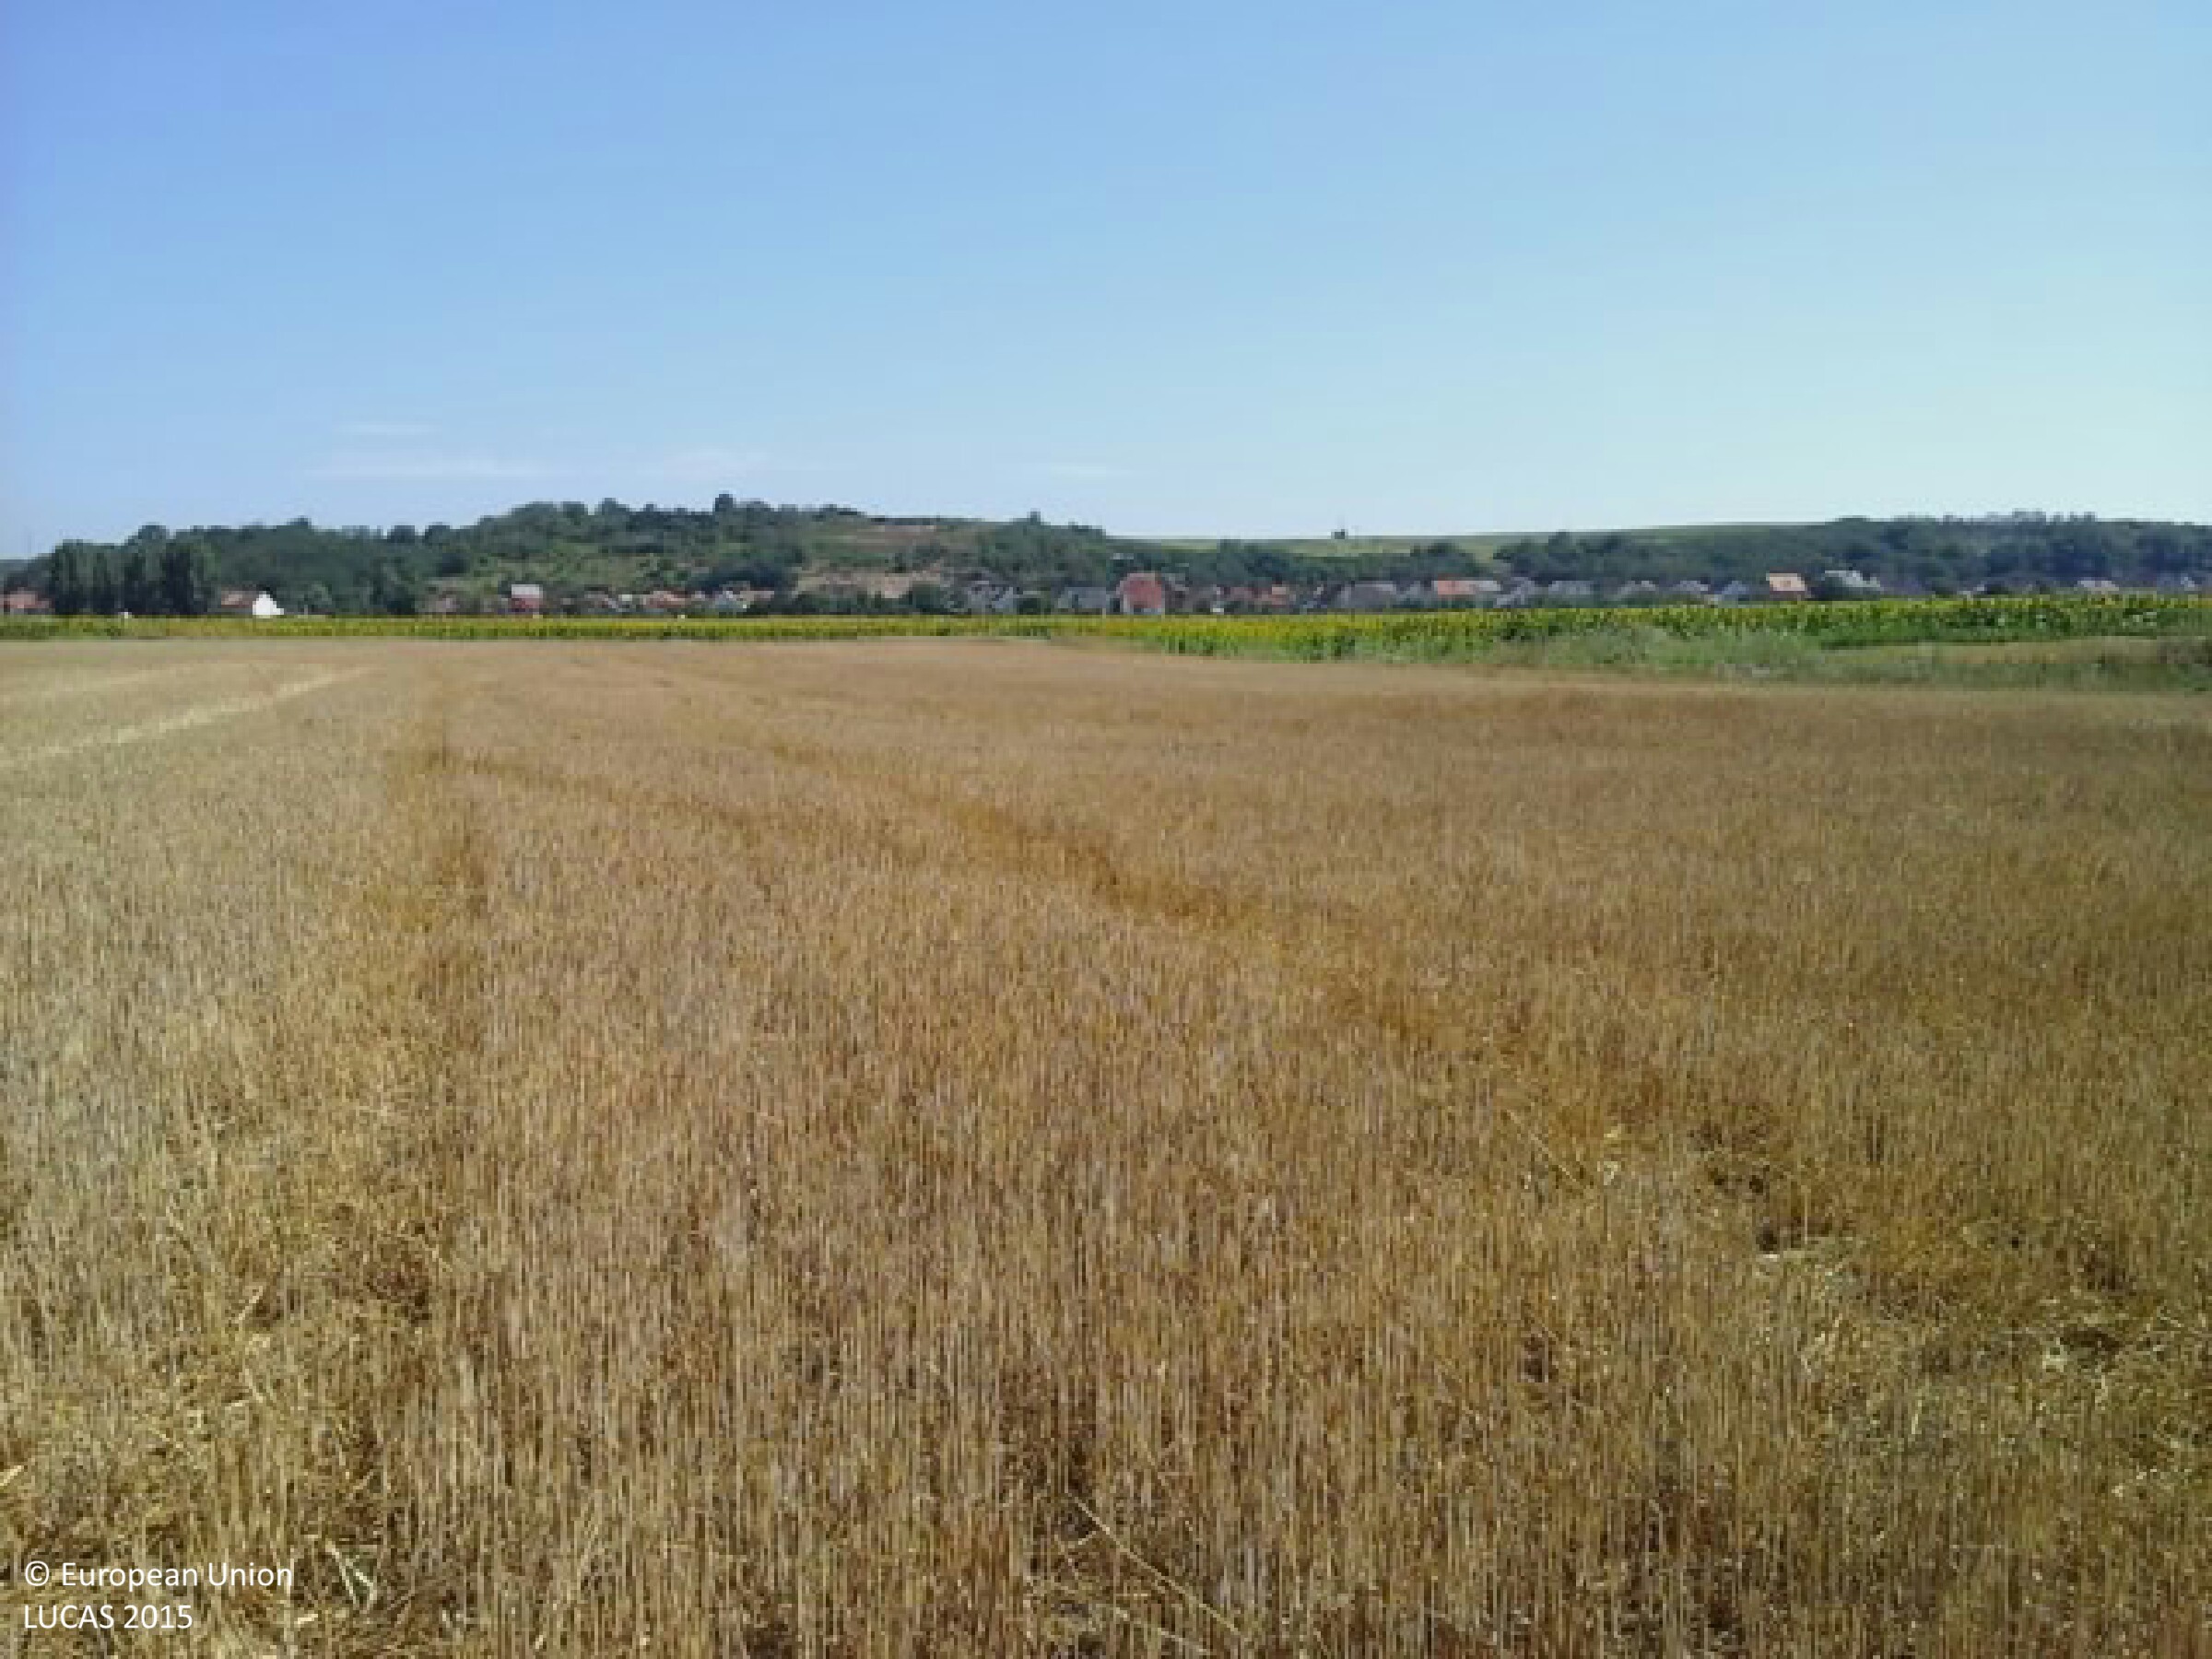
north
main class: Cropland
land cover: Common wheat
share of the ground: > 75 %
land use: Agriculture (excluding fallow land and kitchen gardens)
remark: Harvested field
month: July
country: HU
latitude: 48.2672
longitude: 20.6655
